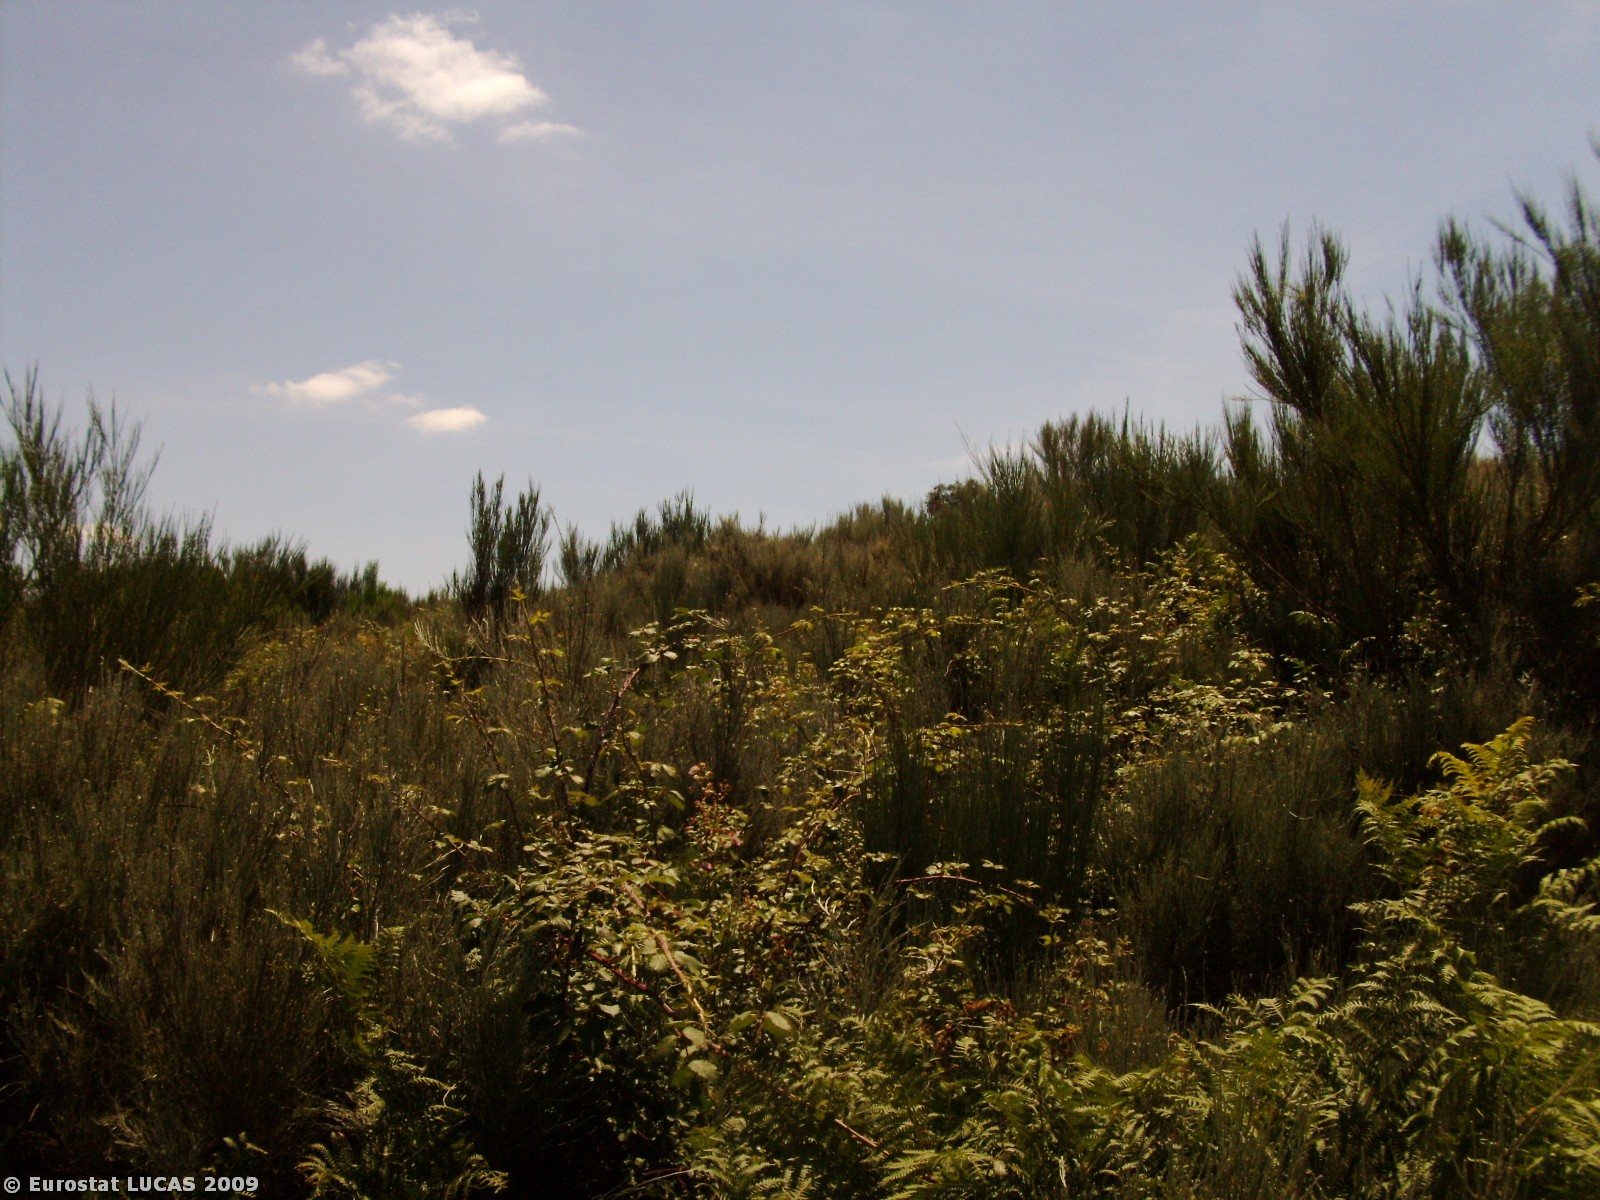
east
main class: Shrubland
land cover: Shrubland without tree cover
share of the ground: > 75 %
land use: Unused
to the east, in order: Shrubland without tree cover; Fences; Shrubland without tree cover; Fences; Shrubland without tree cover; Spontaneously vegetated surfaces; Fences; Shrubland without tree cover; Spontaneously vegetated surfaces; Shrubland without tree cover
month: July
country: PT
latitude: 40.5272
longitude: -7.5964
